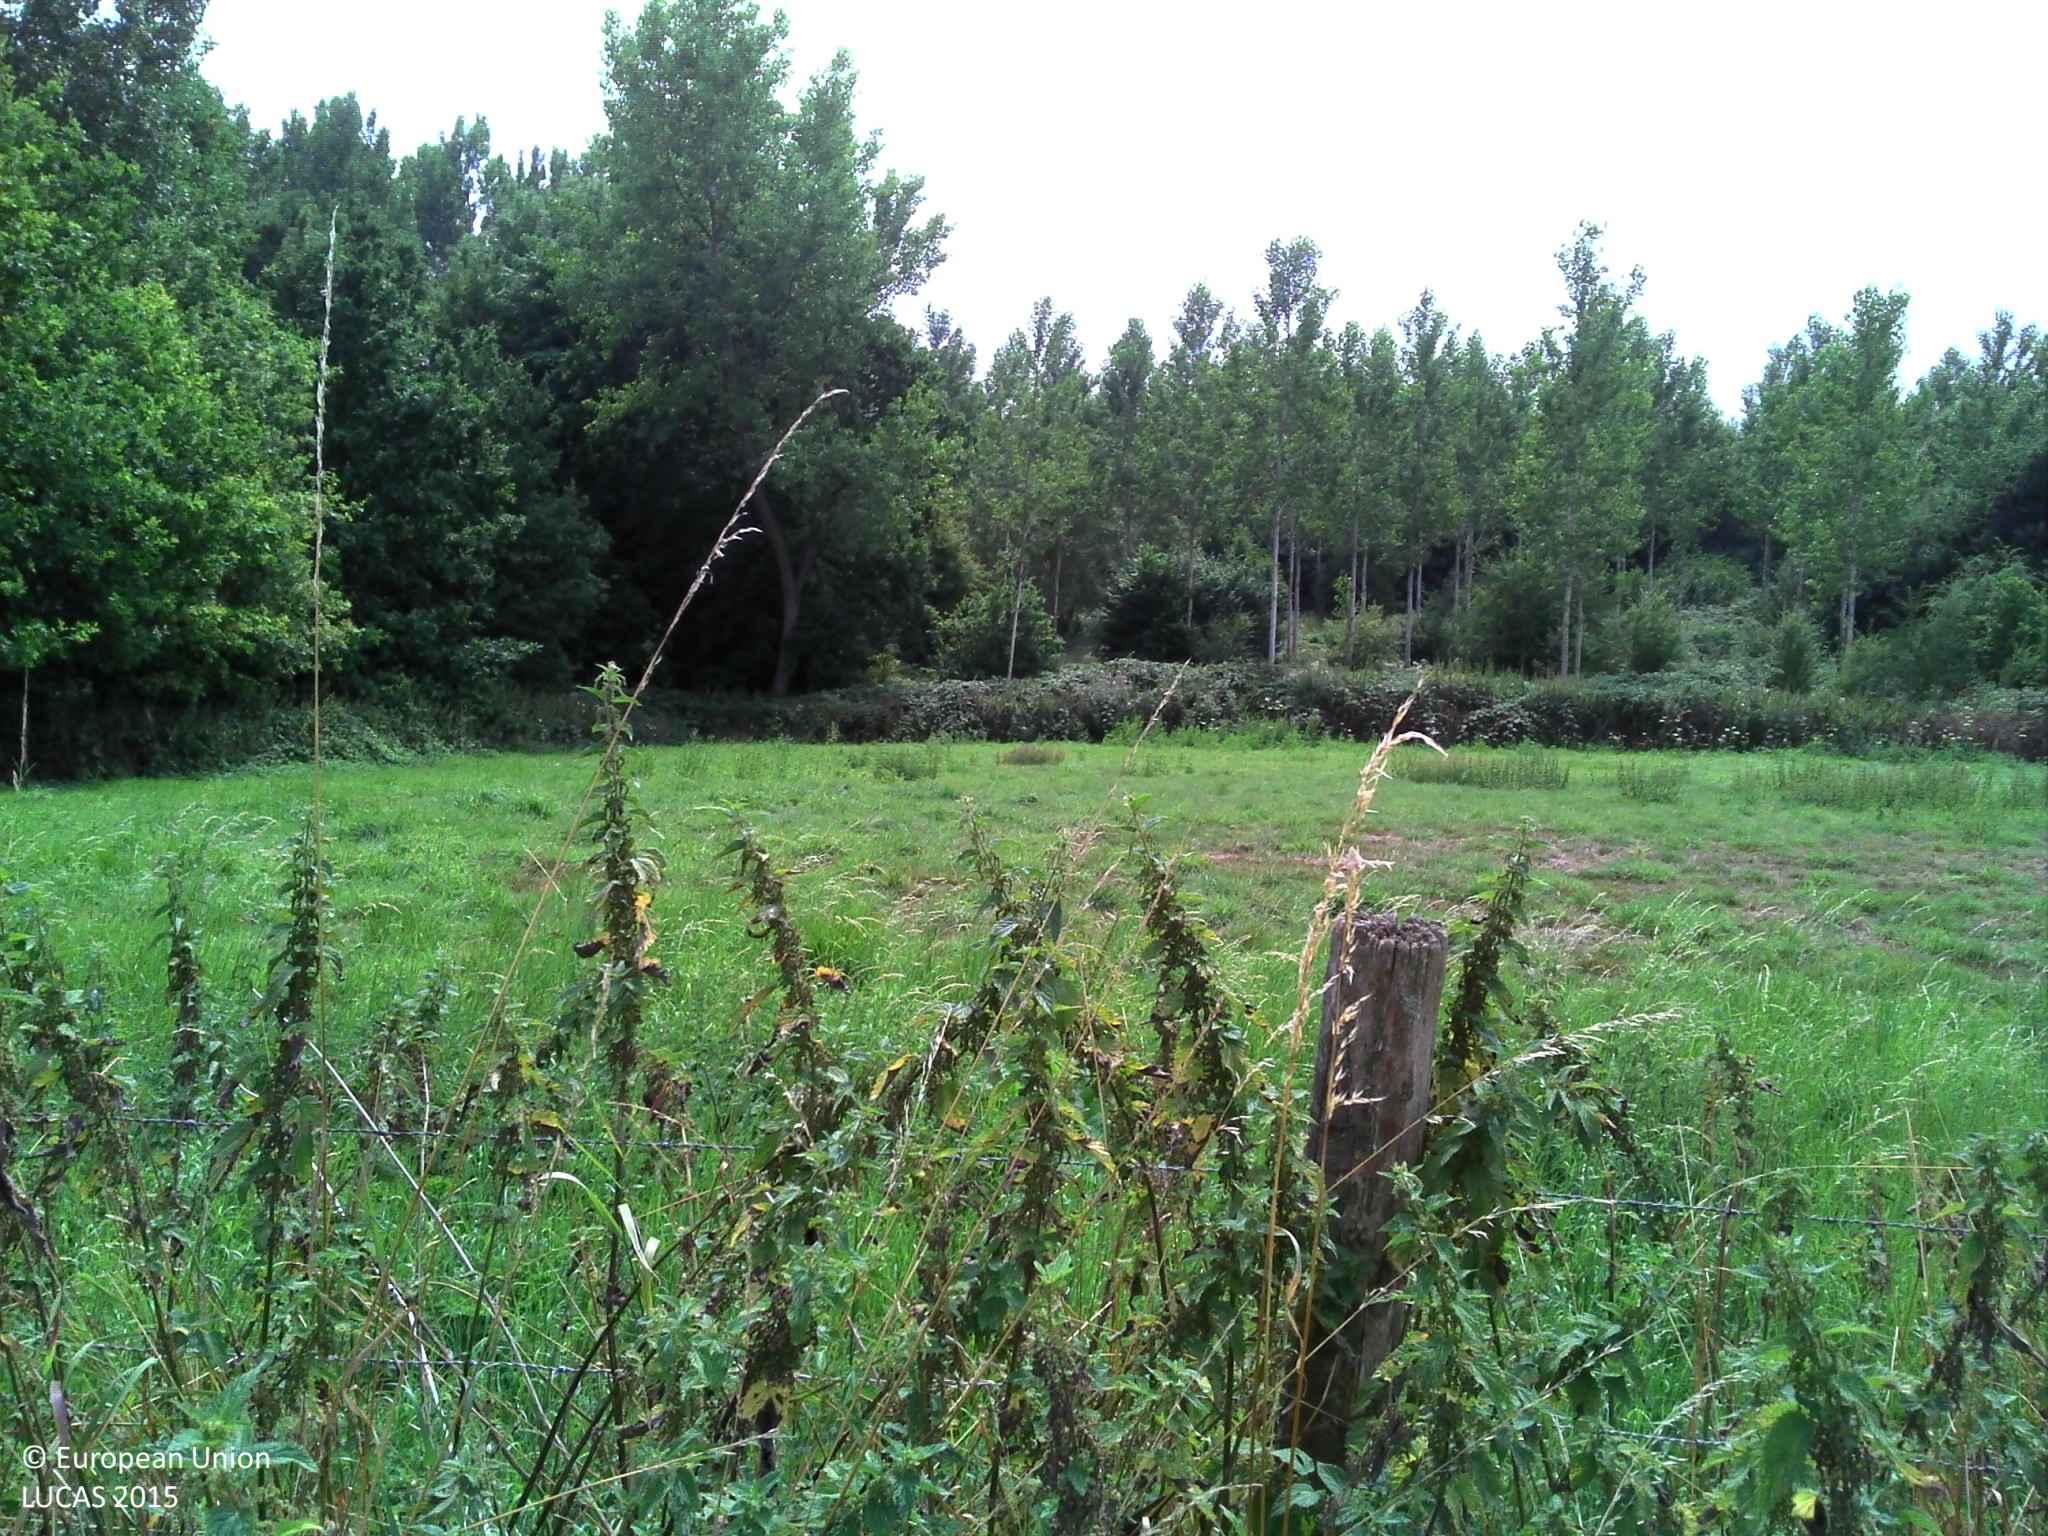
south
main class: Cropland
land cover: Maize
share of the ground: > 75 %
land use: Agriculture (excluding fallow land and kitchen gardens)
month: August
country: BE
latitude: 50.7067
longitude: 3.5779
